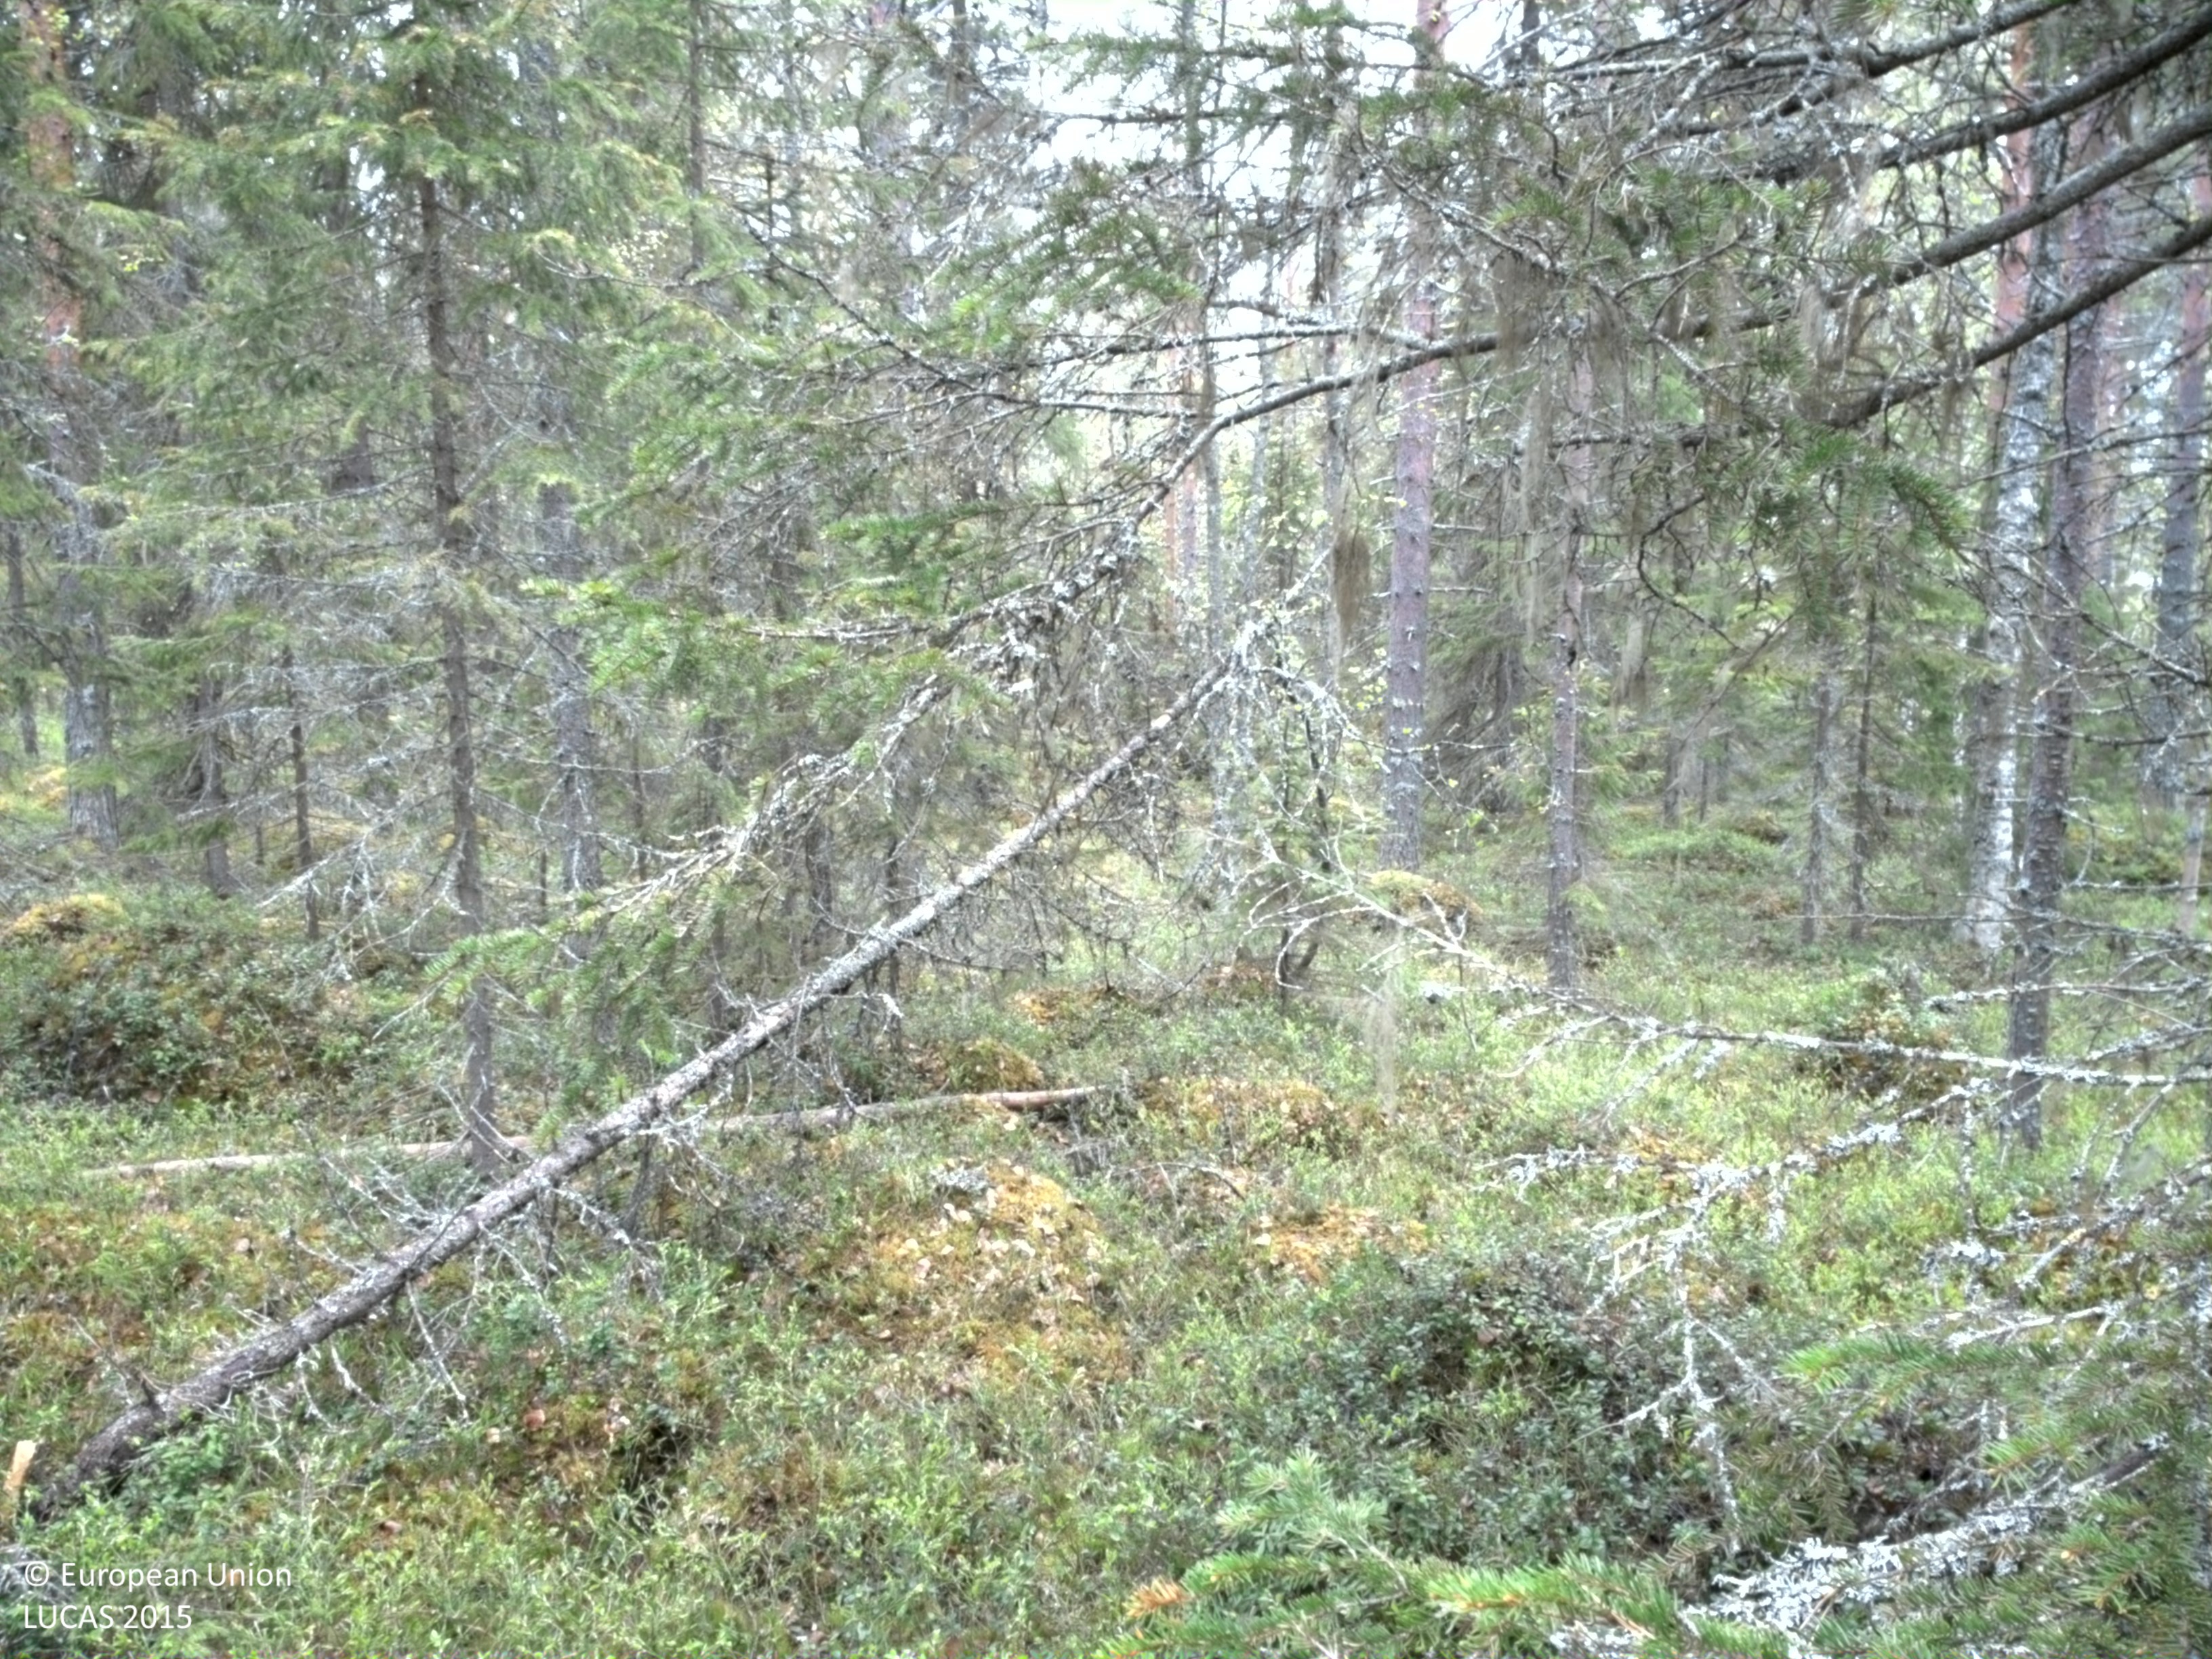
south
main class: Woodland
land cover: Pine dominated coniferous woodland
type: boreal forest
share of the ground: 50 - 75 %
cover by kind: coniferous forest trees 65 %, shrubs 30 %, broadleaved forest trees 5 %
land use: Forestry
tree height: > 5 m
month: June
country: SE
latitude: 65.9885
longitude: 23.0448
